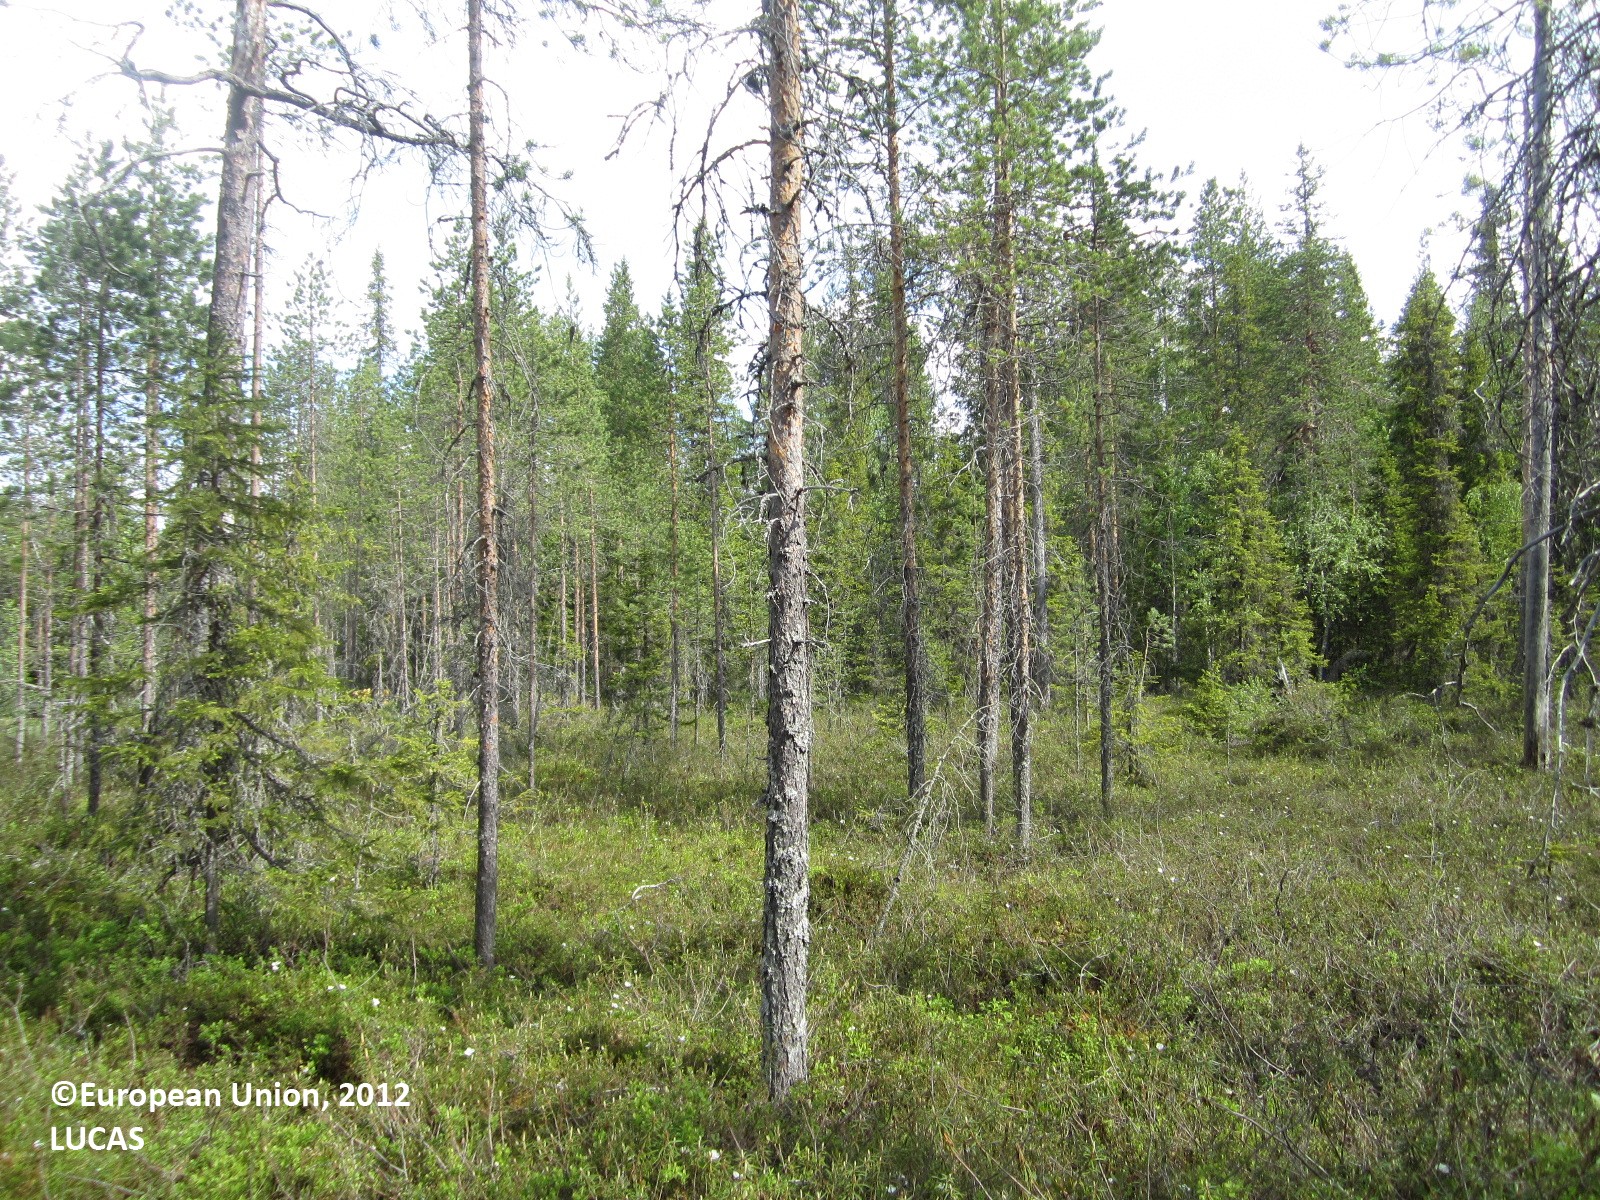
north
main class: Woodland
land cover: Pine dominated coniferous woodland
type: boreal forest
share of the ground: 25 - 50 %
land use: Forestry
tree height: > 5 m
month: June
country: FI
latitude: 64.9410
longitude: 29.2629
